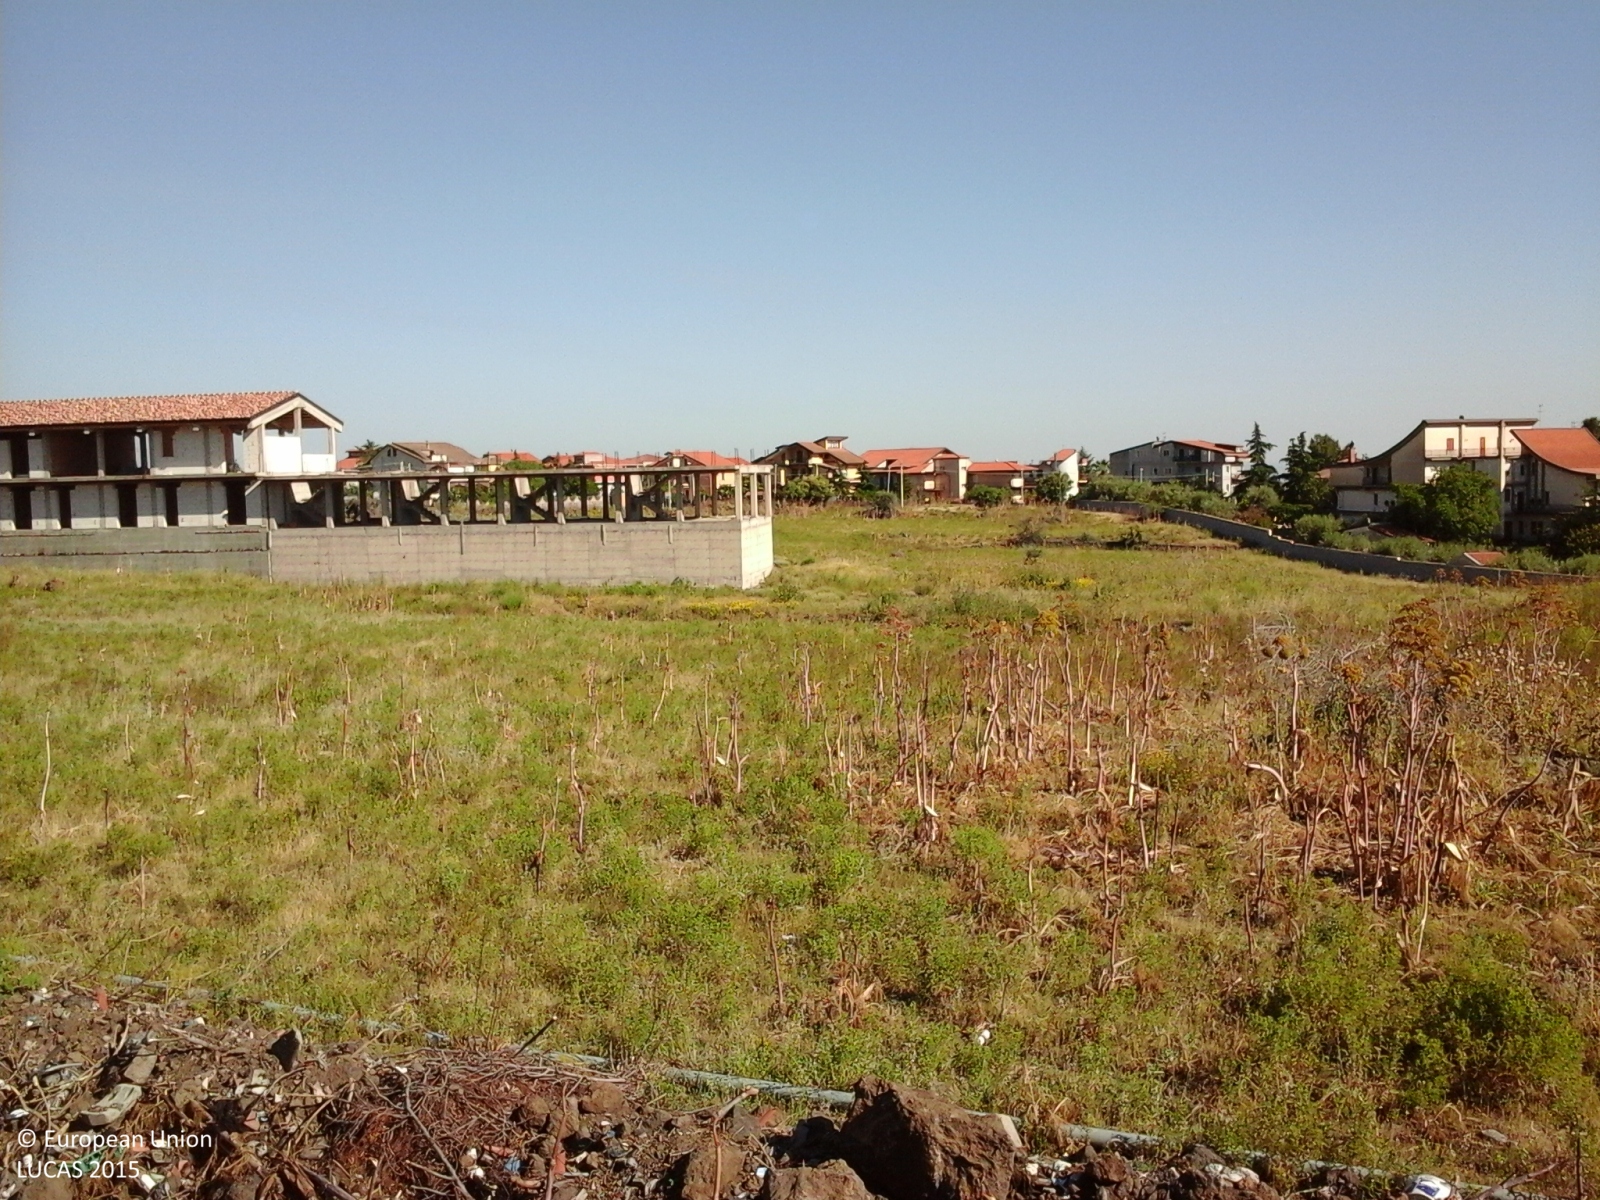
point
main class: Grassland
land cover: Grassland without tree/shrub cover
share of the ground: > 75 %
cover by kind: herbaceous plants 100 %
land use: Abandoned areas
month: May
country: IT
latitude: 37.6215
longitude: 14.8938
